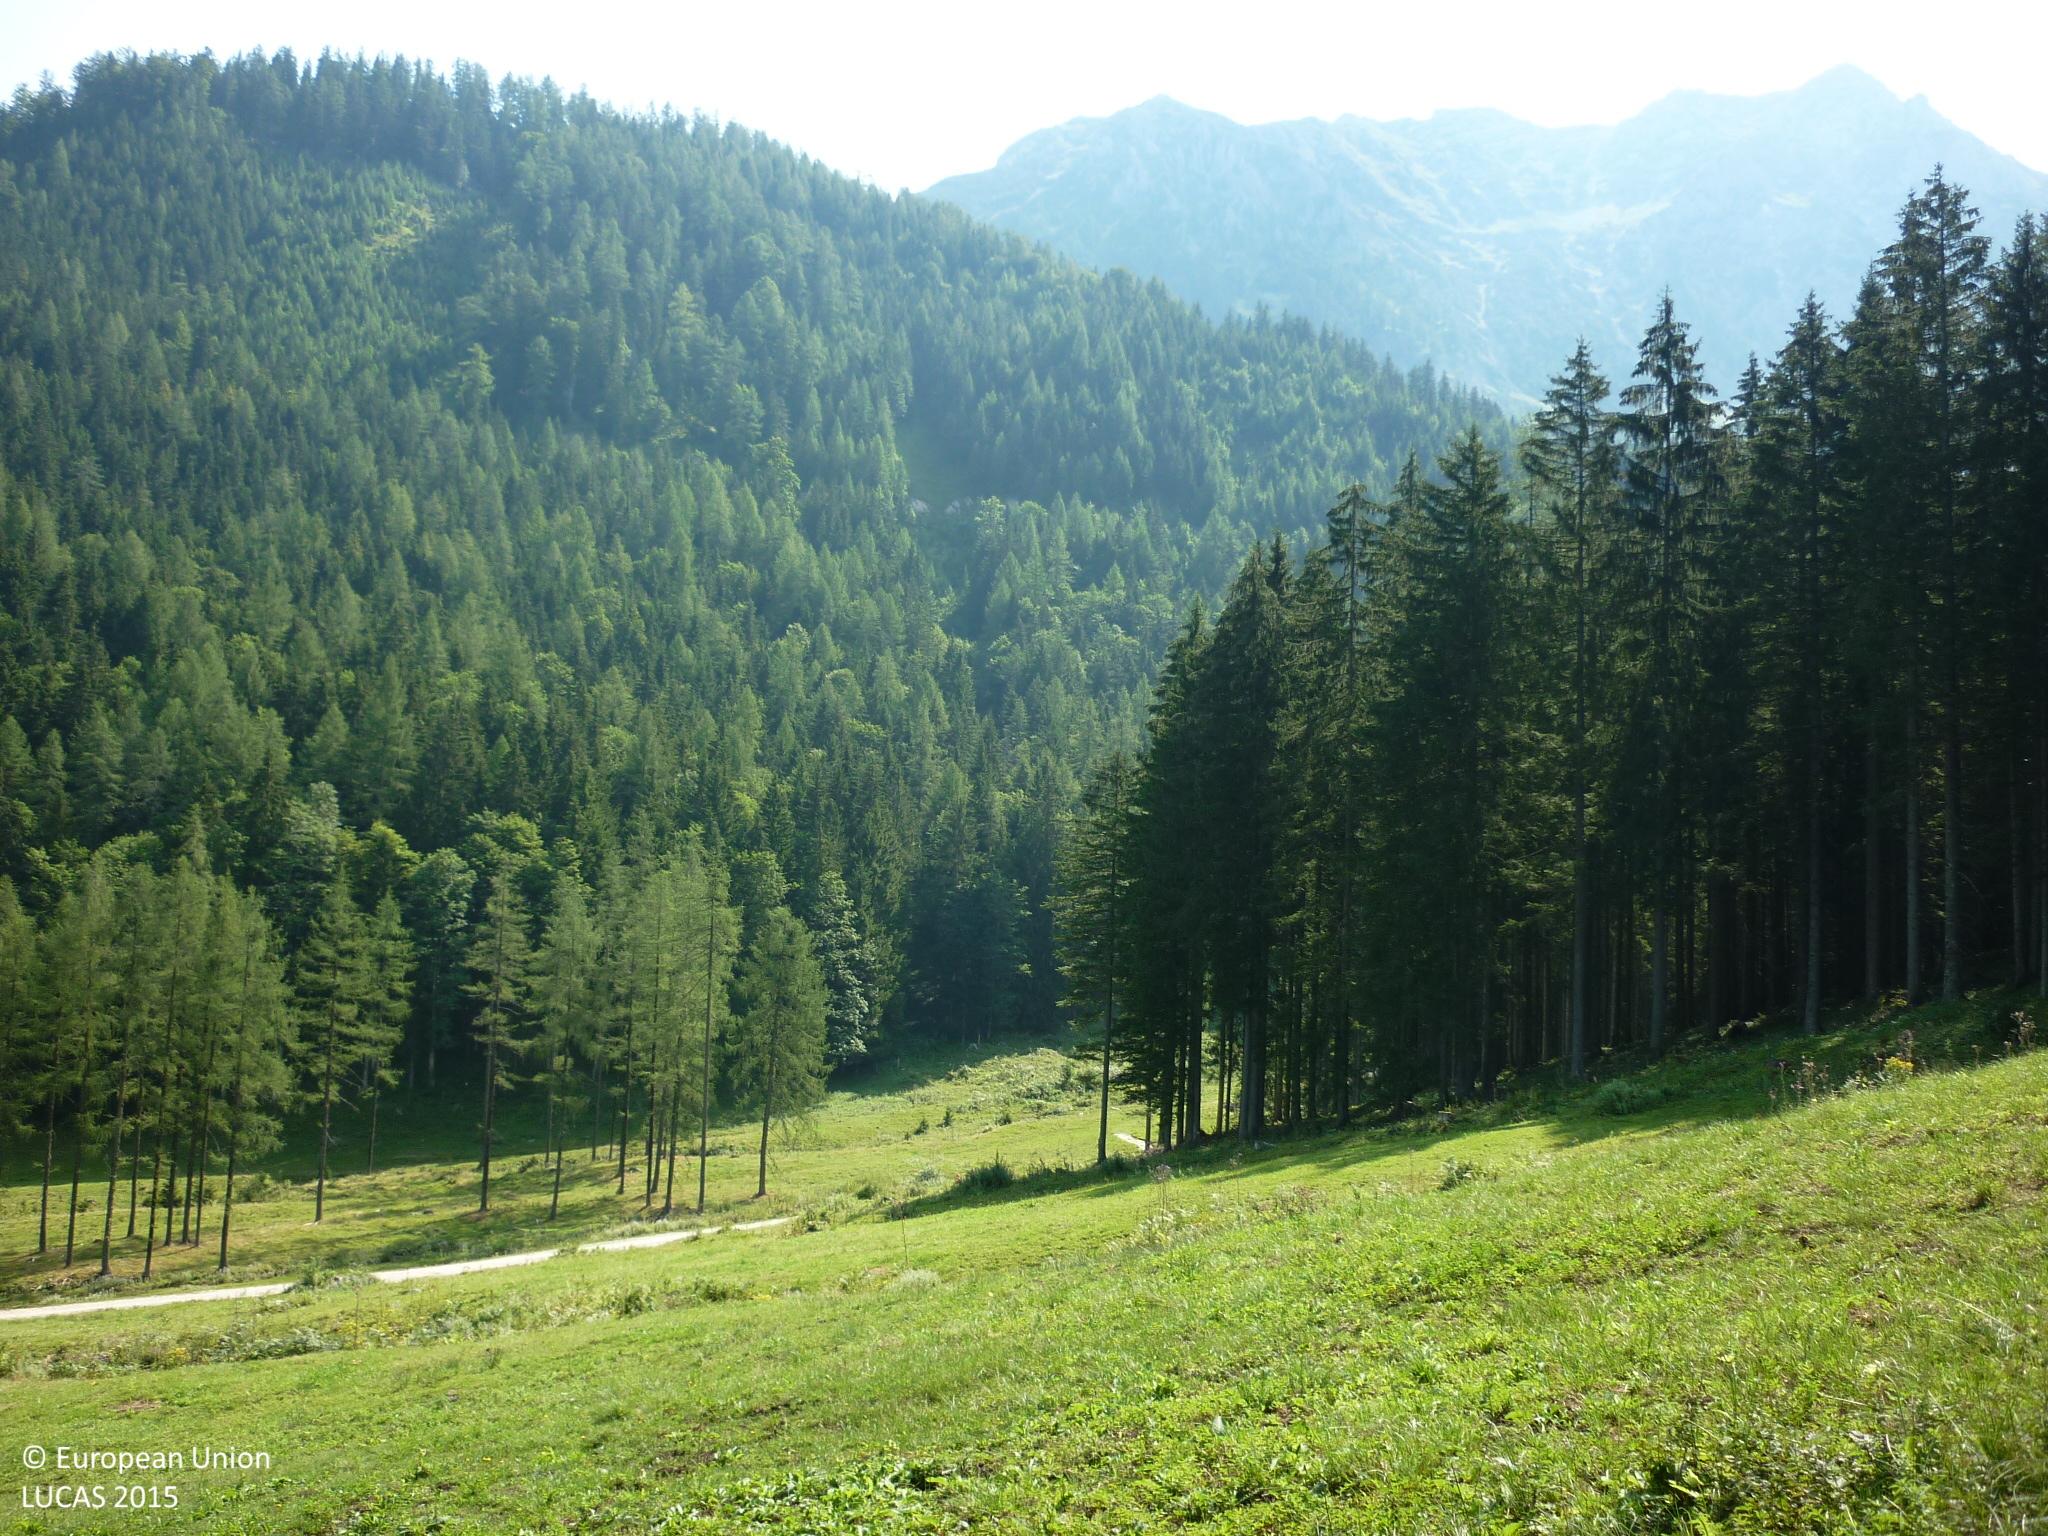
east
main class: Grassland
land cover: Grassland without tree/shrub cover
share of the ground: > 75 %
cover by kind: herbaceous plants 100 %
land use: Agriculture (excluding fallow land and kitchen gardens)
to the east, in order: Grassland without tree/shrub cover; Tracks; Grassland with sparse tree/shrub cover; Rivers and streams; Grassland without tree/shrub cover; Rivers and streams; Grassland with sparse tree/shrub cover; Fences; Spruce dominated coniferous woodland
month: August
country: AT
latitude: 47.6679
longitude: 14.3808
